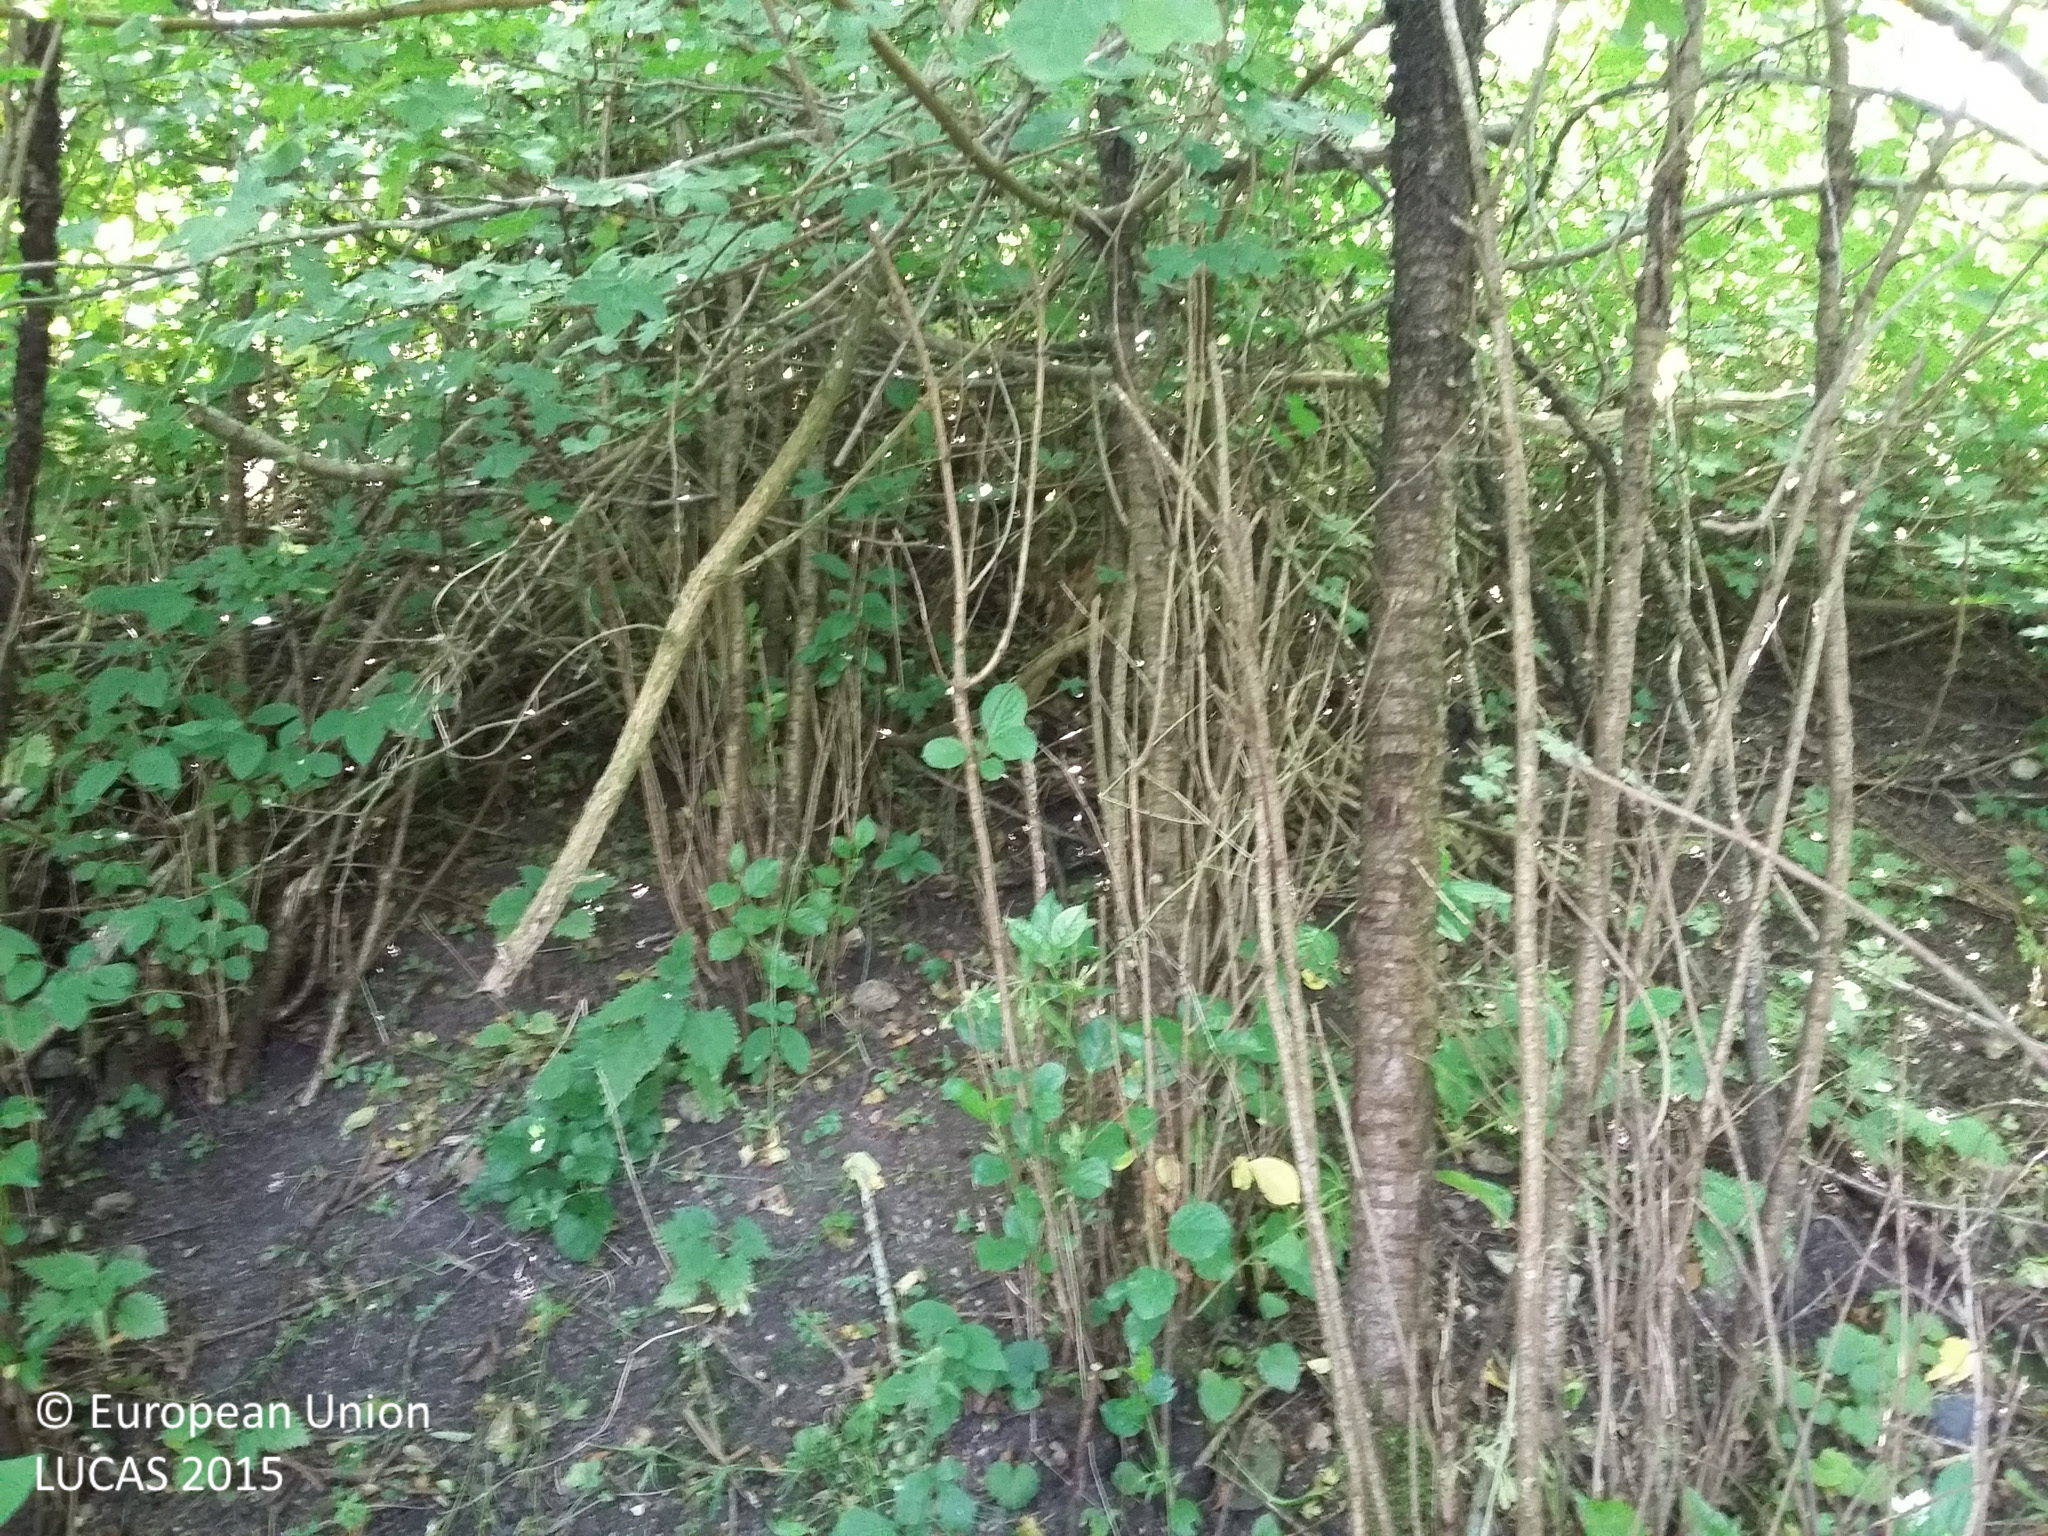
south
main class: Woodland
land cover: Broadleaved woodland
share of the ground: > 75 %
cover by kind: broadleaved forest trees 90 %, herbaceous plants 10 %
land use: Railway transport
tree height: > 5 m
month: July
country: DK
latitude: 55.5314
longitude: 11.5354
